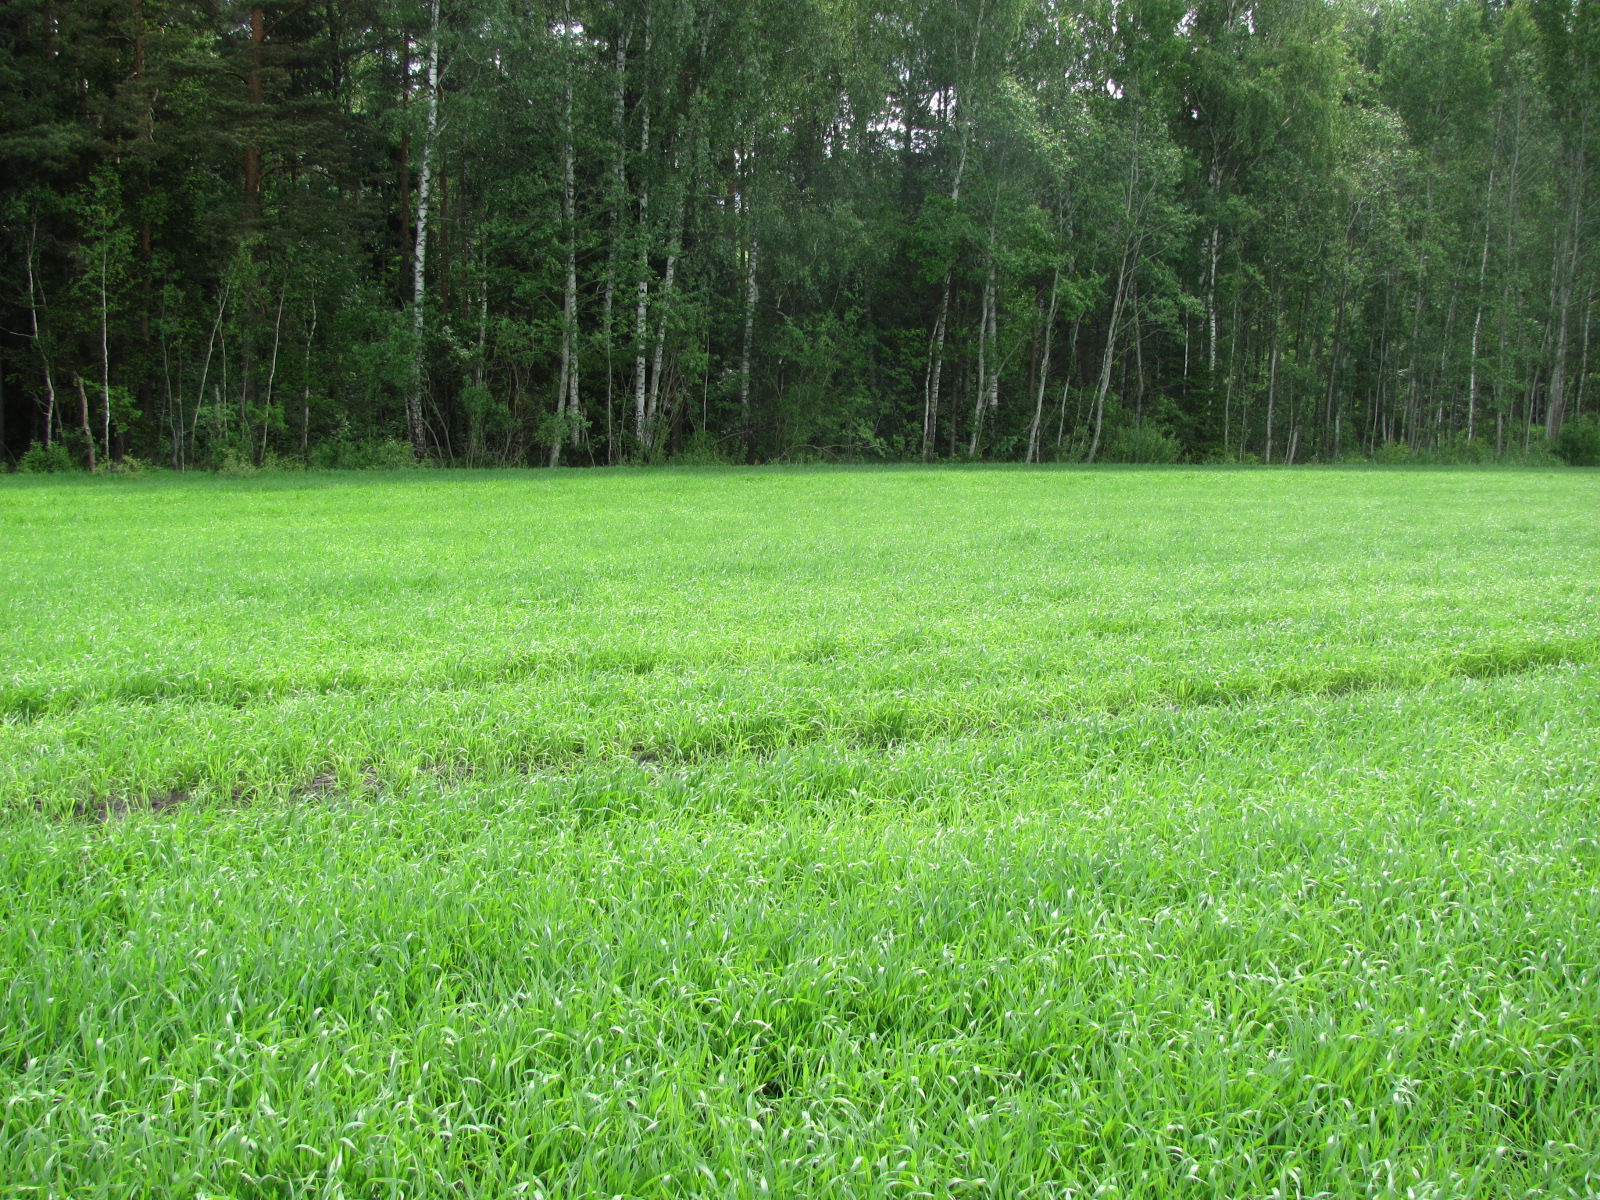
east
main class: Cropland
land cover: Common wheat
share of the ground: > 75 %
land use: Agriculture (excluding fallow land and kitchen gardens)
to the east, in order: Common wheat; Shruby margins; Other mixed woodland; Ditches and canals; Broadleaved woodland; Spontaneously vegetated surfaces; Potatoes
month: June
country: LV
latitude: 56.6899
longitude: 23.8781
